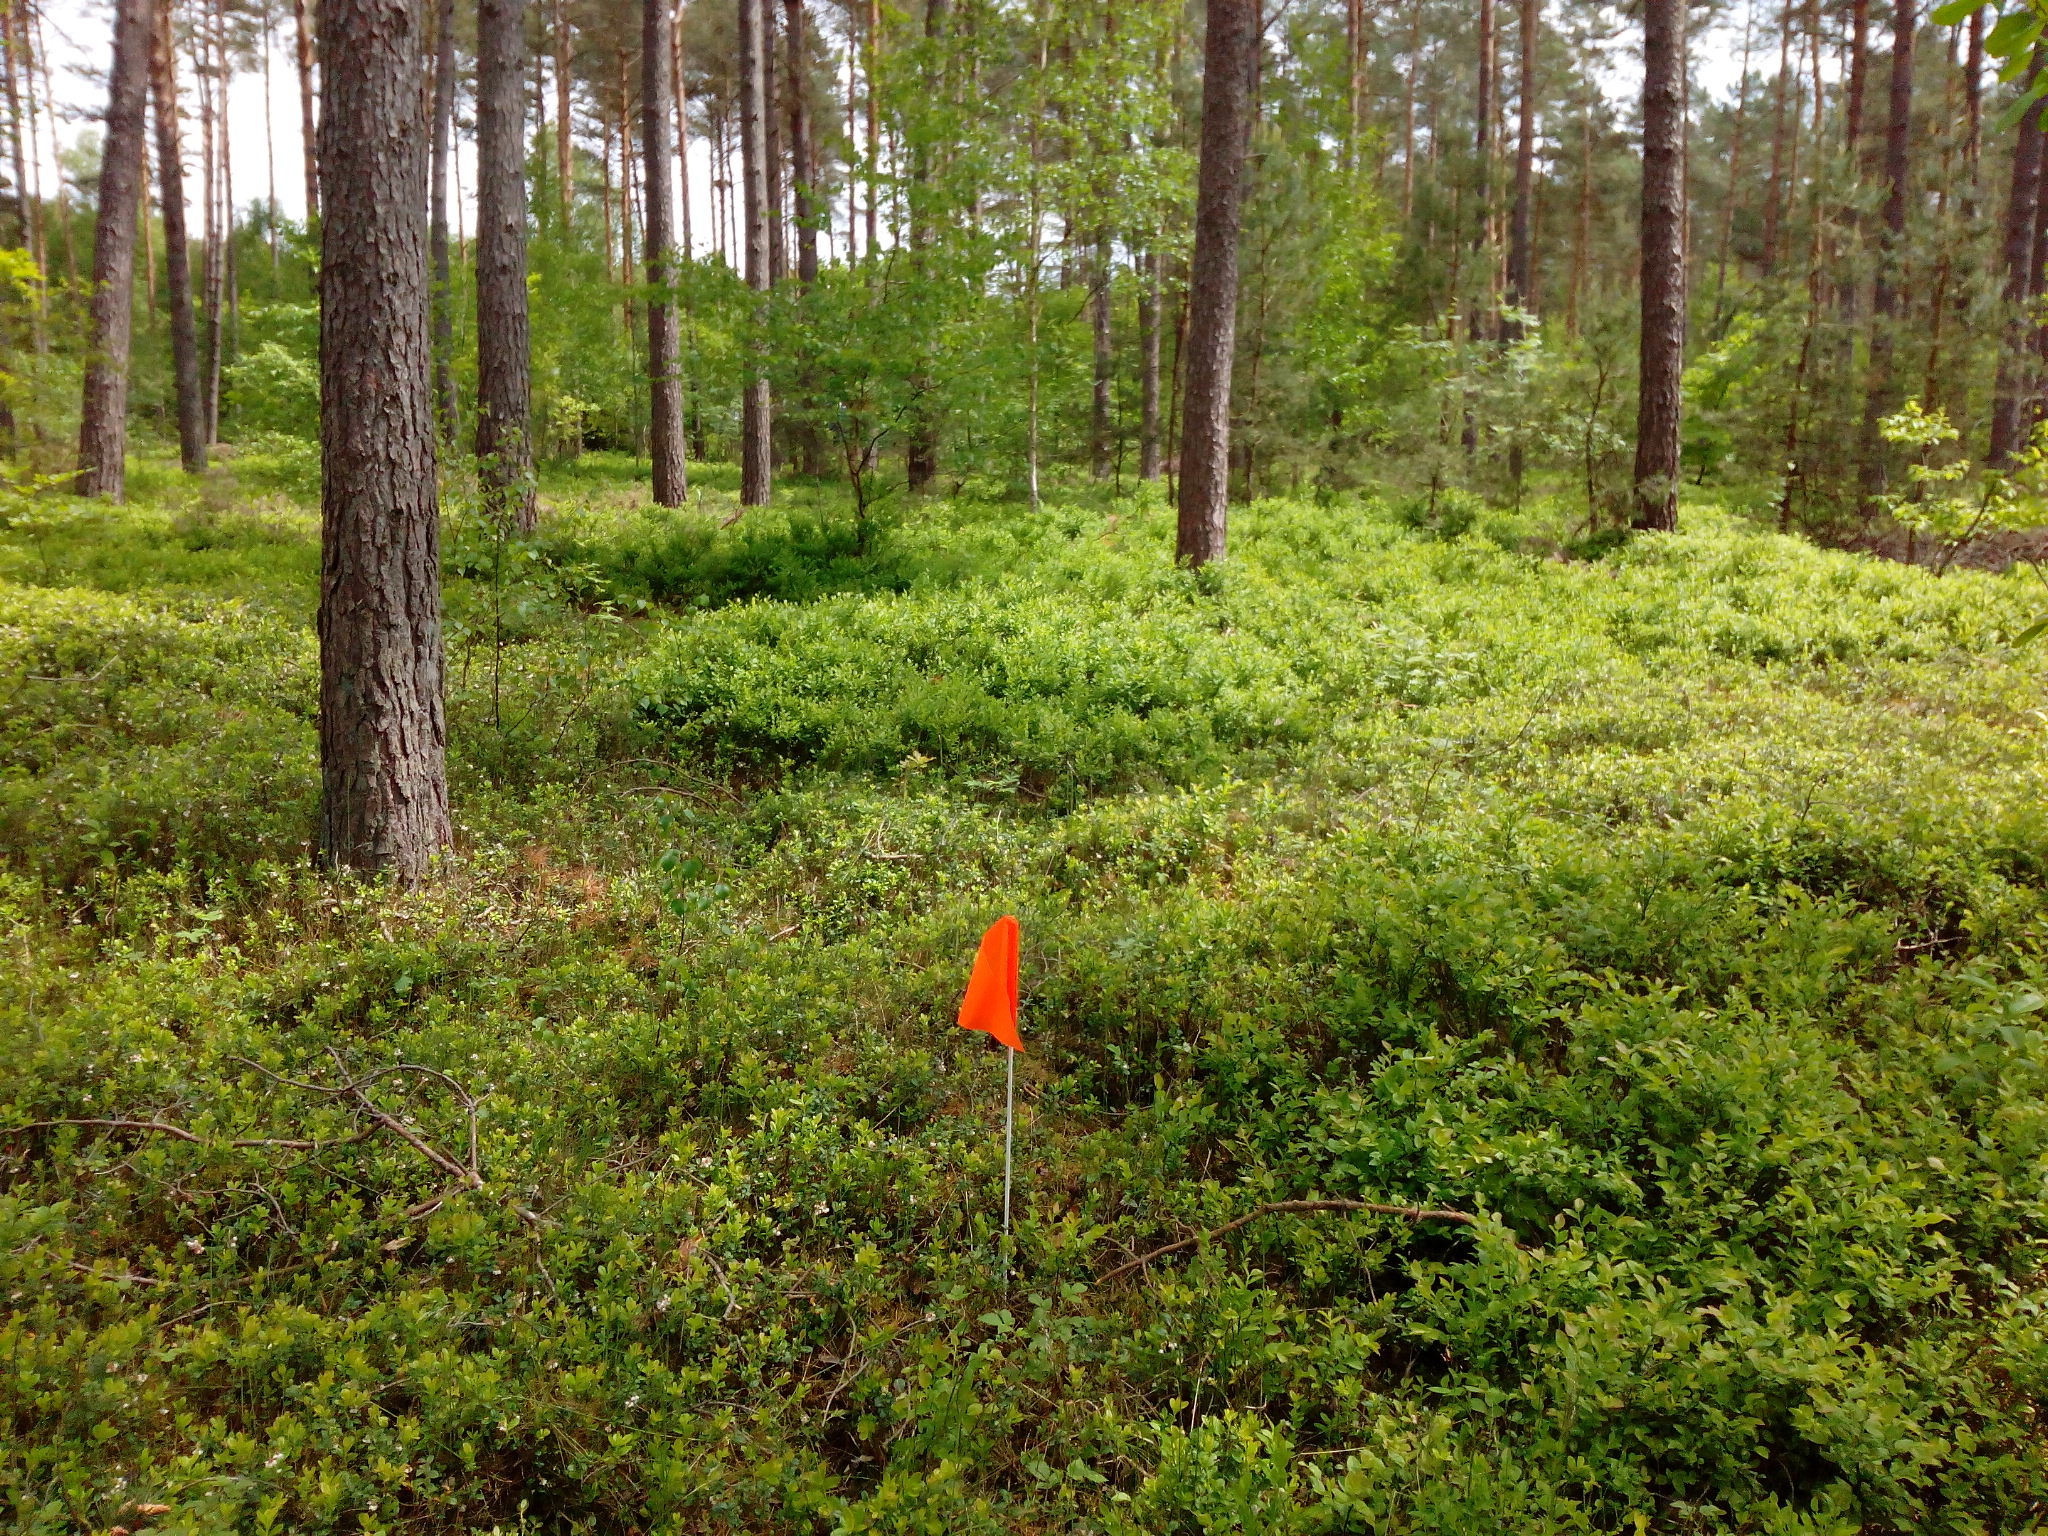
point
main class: Woodland
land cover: Pine dominated coniferous woodland
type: hemiboreal forest and nemoral coniferous forest and mixed broadleaved-coniferous forest
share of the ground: 50 - 75 %
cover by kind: coniferous forest trees 60 %, herbaceous plants 30 %, broadleaved forest trees 5 %, shrubs 5 %
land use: Forestry
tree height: > 5 m
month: June
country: DE
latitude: 52.7189
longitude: 9.8668
